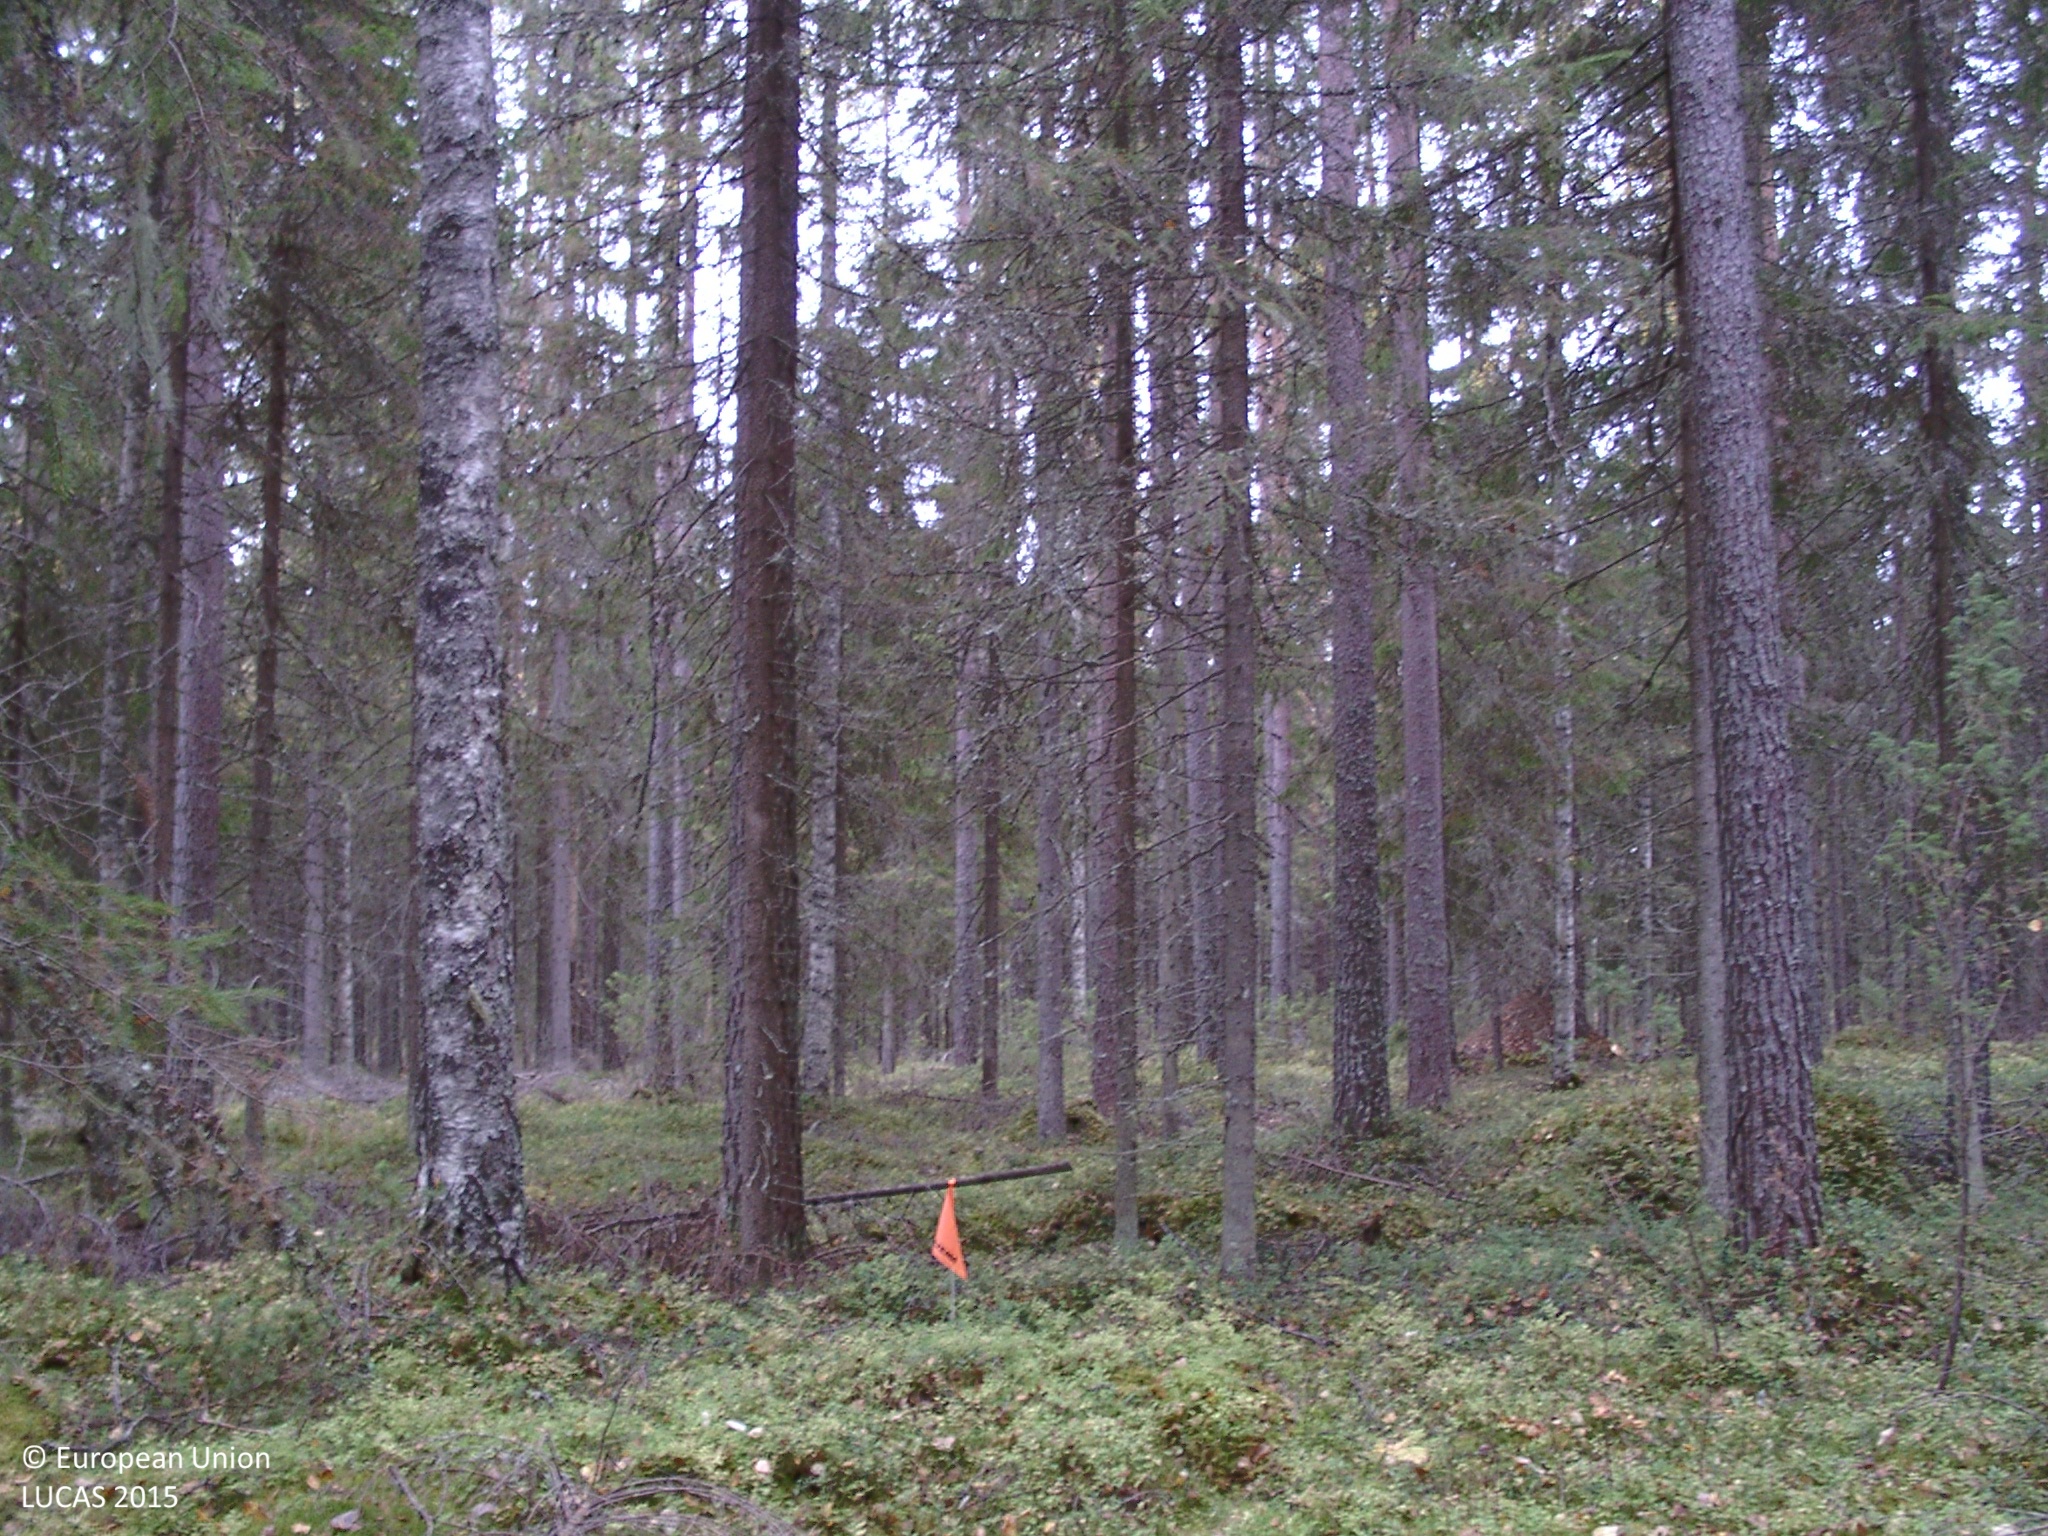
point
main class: Woodland
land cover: Spruce dominated coniferous woodland
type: boreal forest
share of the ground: 50 - 75 %
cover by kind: coniferous forest trees 65 %, shrubs 15 %, lichens and mosses 15 %, broadleaved forest trees 5 %
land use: Forestry
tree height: > 5 m
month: September
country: FI
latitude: 62.5941
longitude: 25.1562
